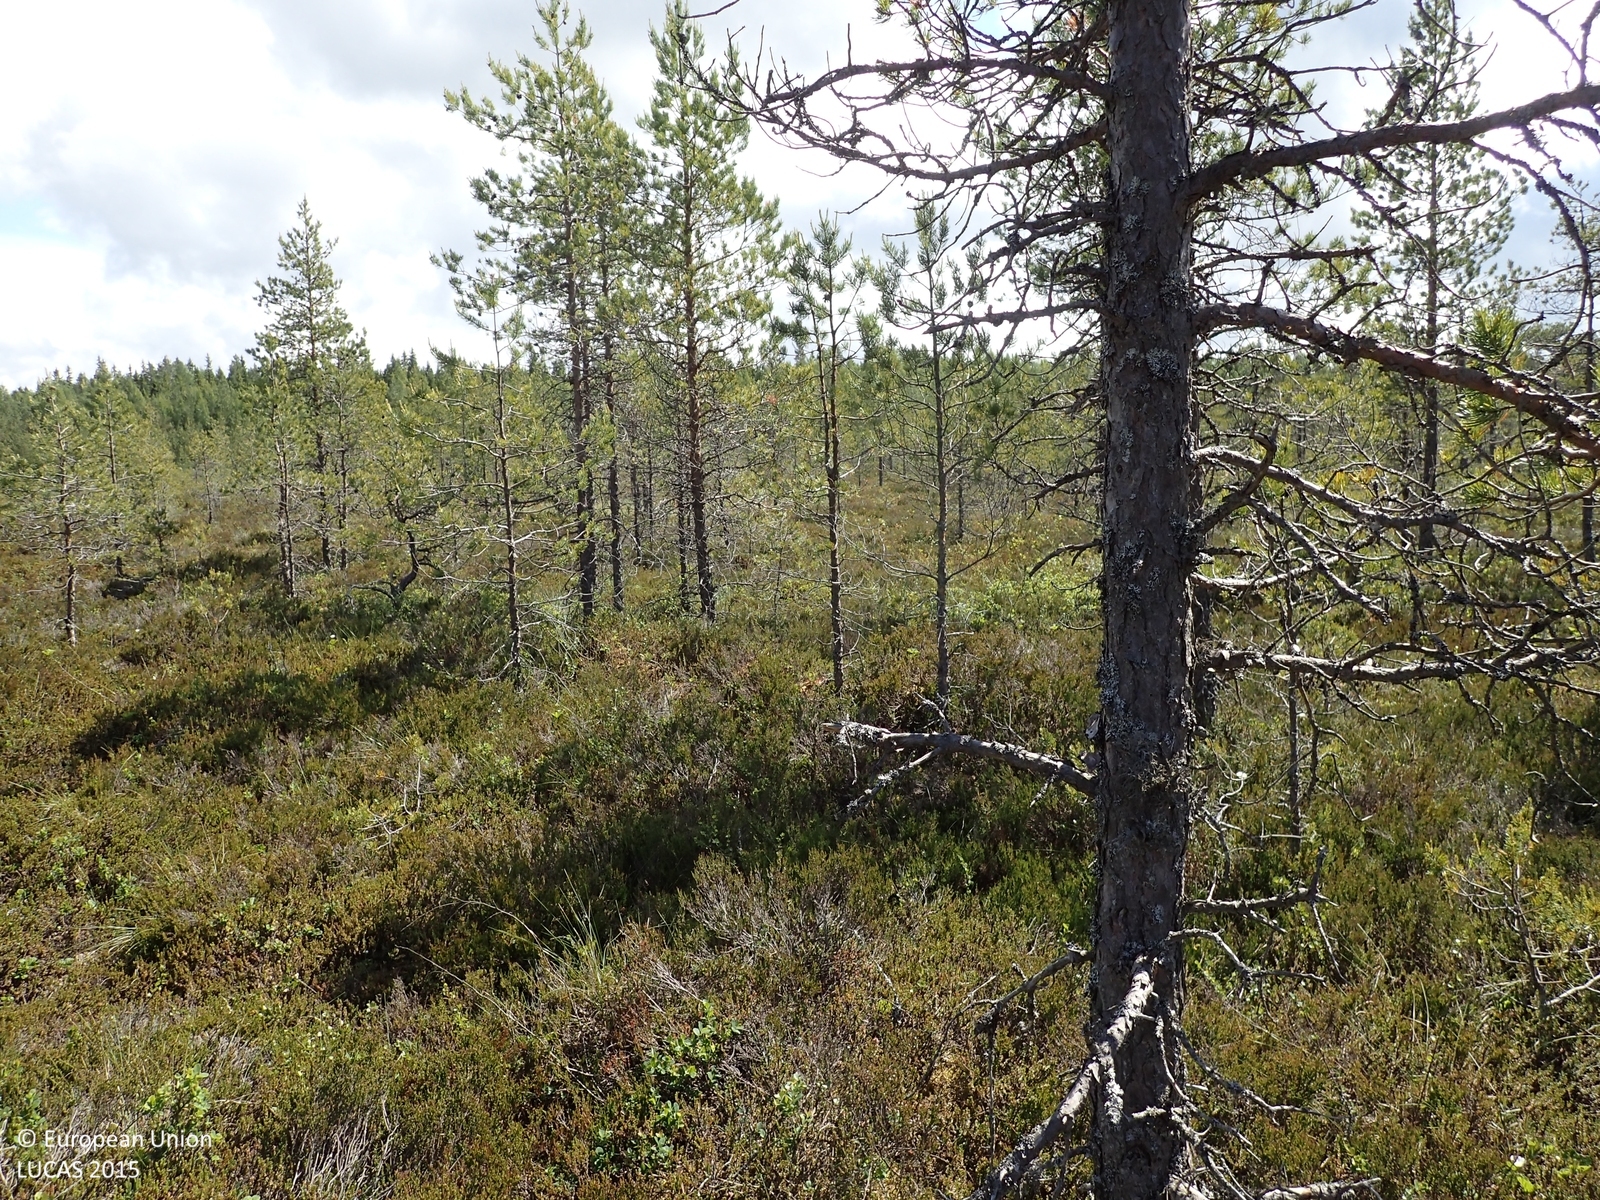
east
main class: Woodland
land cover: Pine dominated coniferous woodland
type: mire and swamp forests
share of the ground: 10 - 25 %
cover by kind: shrubs 80 %, coniferous forest trees 15 %, lichens and mosses 5 %
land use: Semi-natural and natural areas not in use
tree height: < 5 m
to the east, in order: Pine dominated coniferous woodland; Ditches and canals; Pine dominated coniferous woodland; Ditches and canals; Pine dominated mixed woodland; Other mixed woodland; Ditches and canals
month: June
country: FI
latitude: 62.3913
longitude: 21.4751
